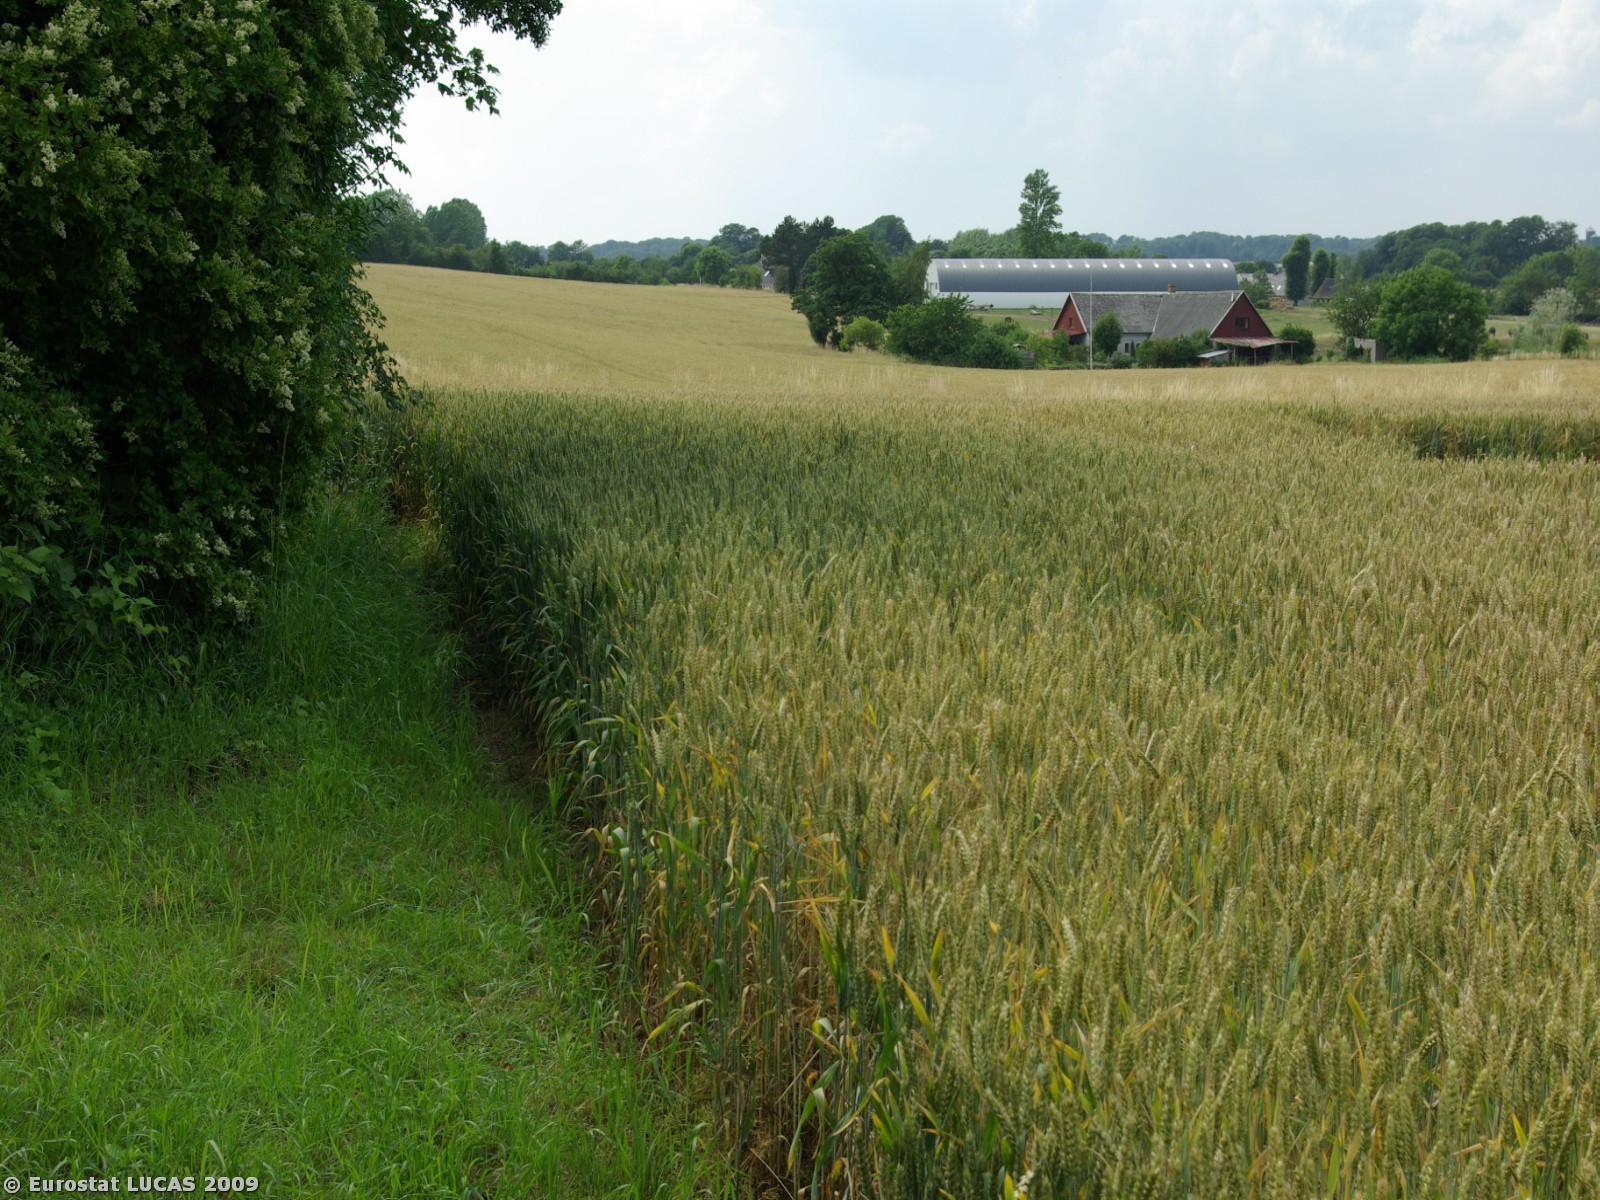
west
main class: Cropland
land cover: Common wheat
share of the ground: > 75 %
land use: Agriculture (excluding fallow land and kitchen gardens)
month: July
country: DK
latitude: 55.0014
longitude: 9.9219
